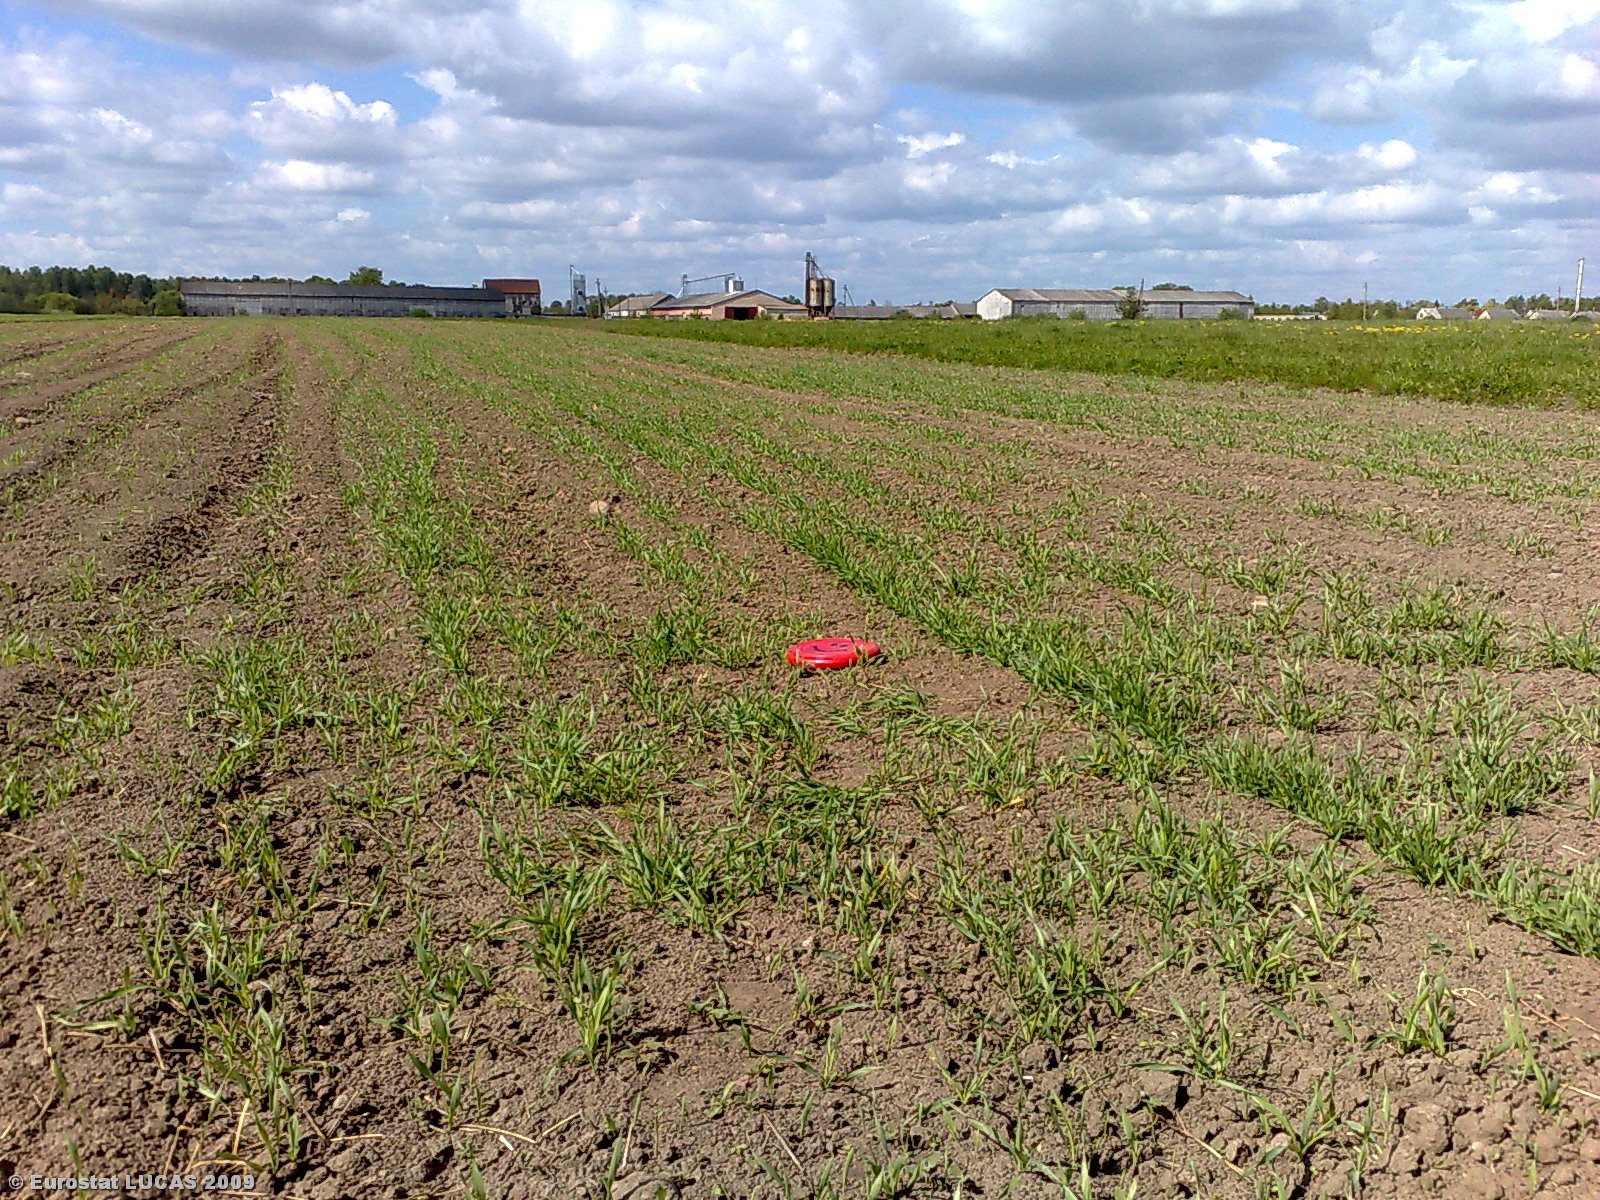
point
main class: Cropland
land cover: Barley
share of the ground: 25 - 50 %
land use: Agriculture (excluding fallow land and kitchen gardens)
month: May
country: LT
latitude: 55.6953
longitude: 23.9446
